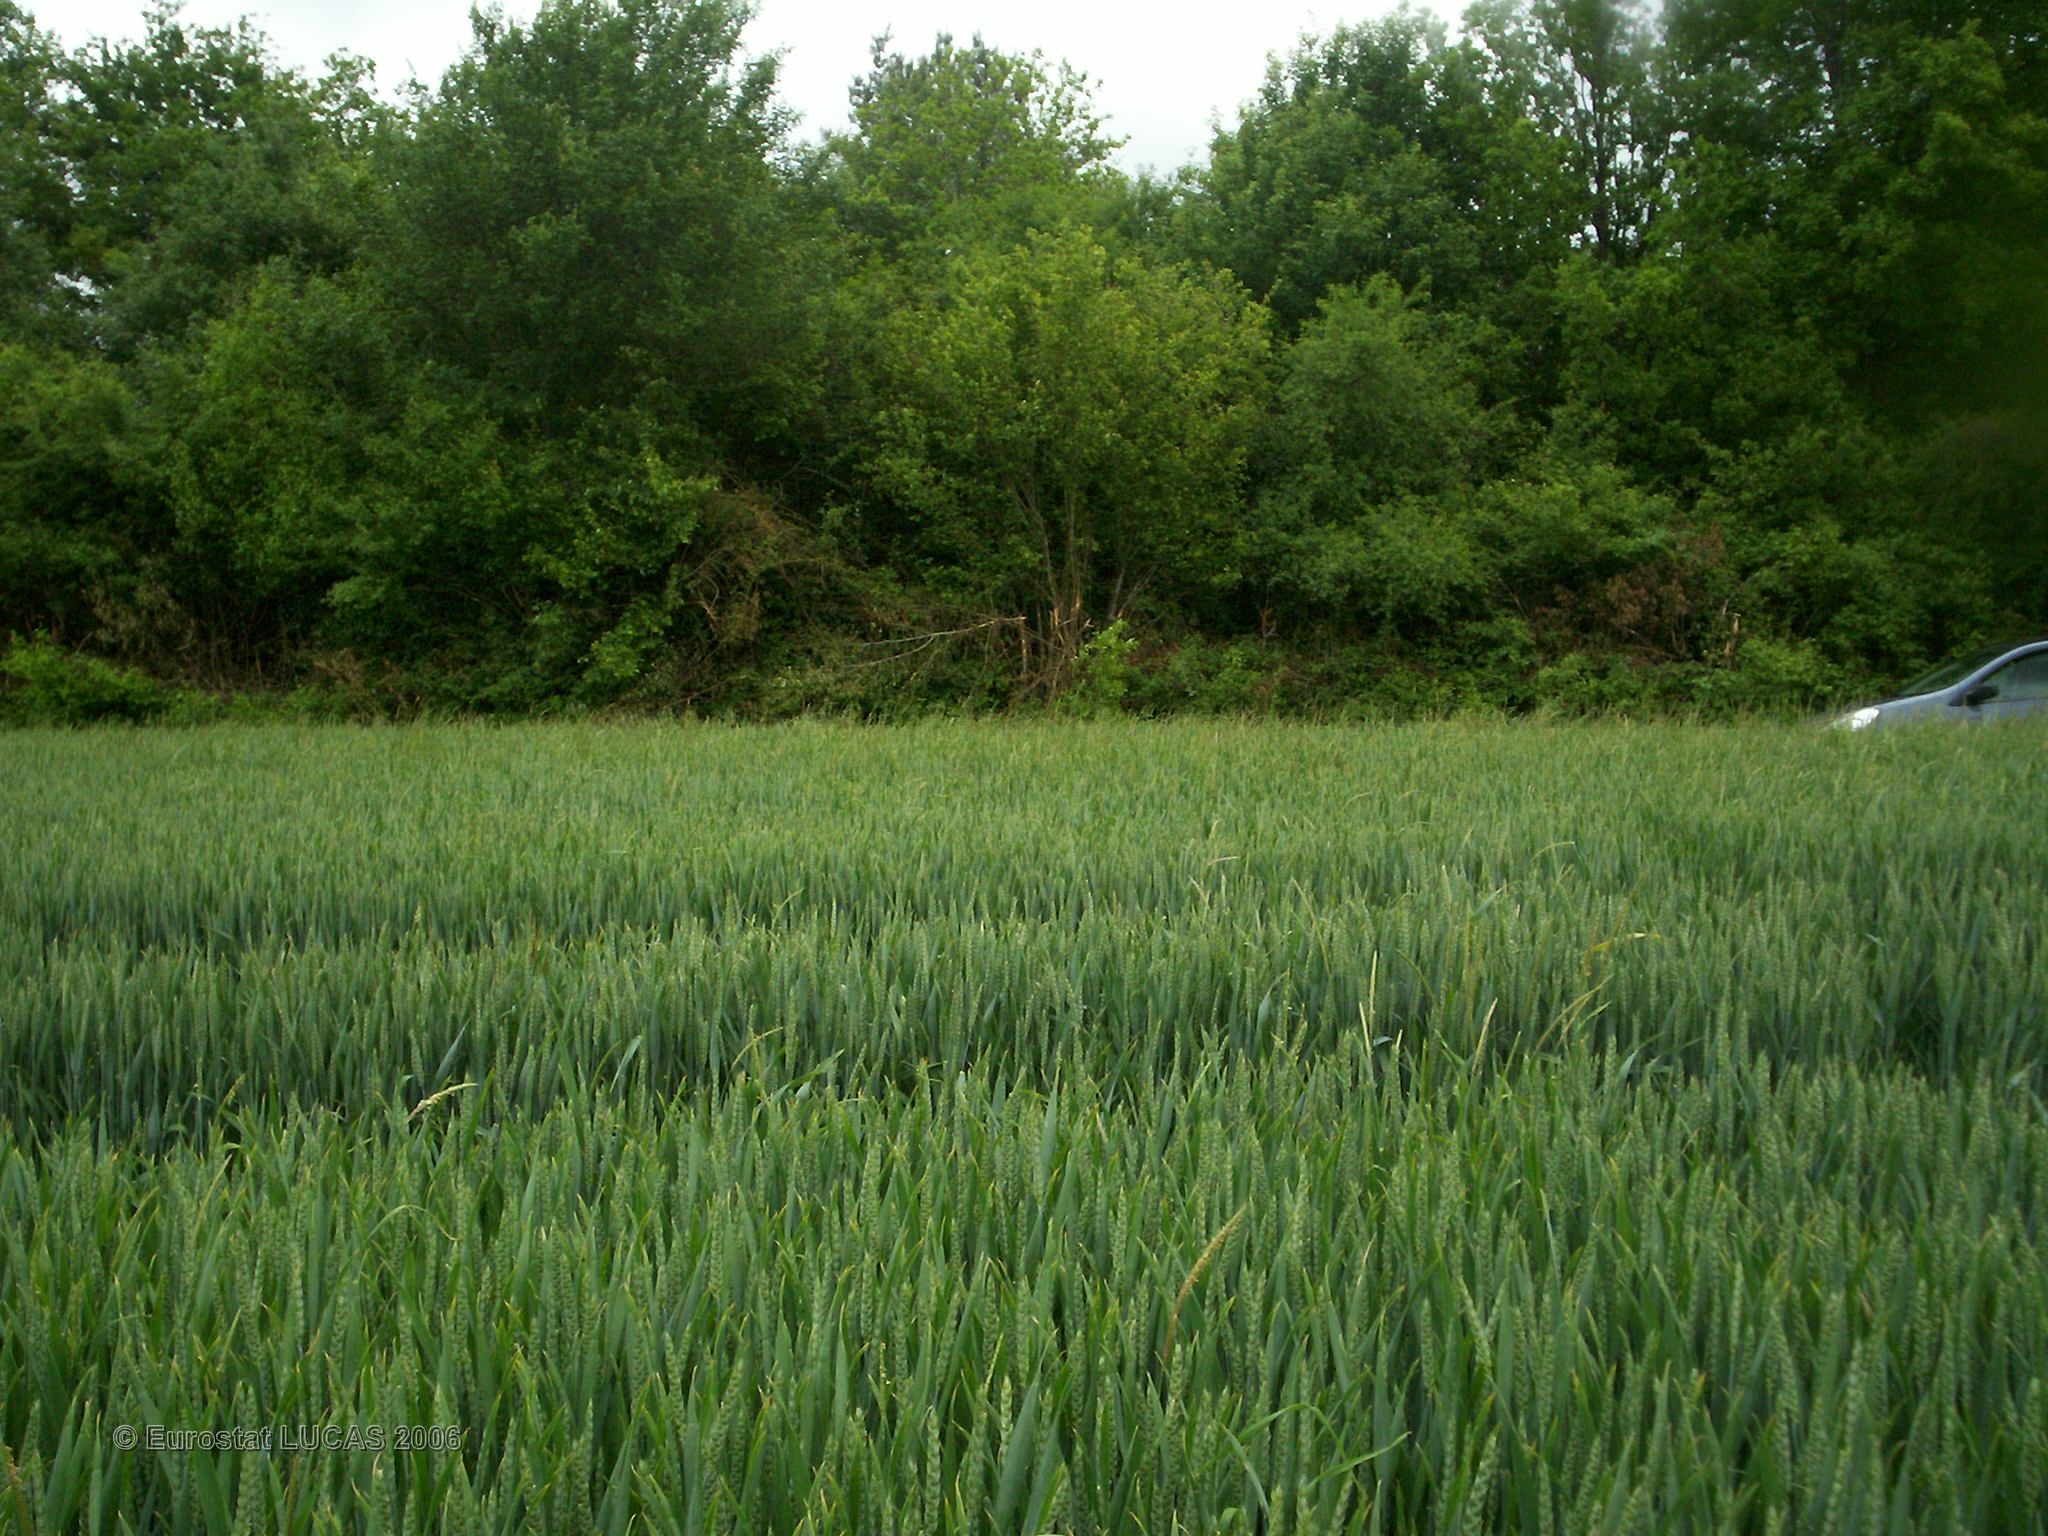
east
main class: Cropland
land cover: Common wheat
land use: Agriculture (excluding fallow land and kitchen gardens)
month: May
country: FR
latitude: 47.6089
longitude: 3.9980
